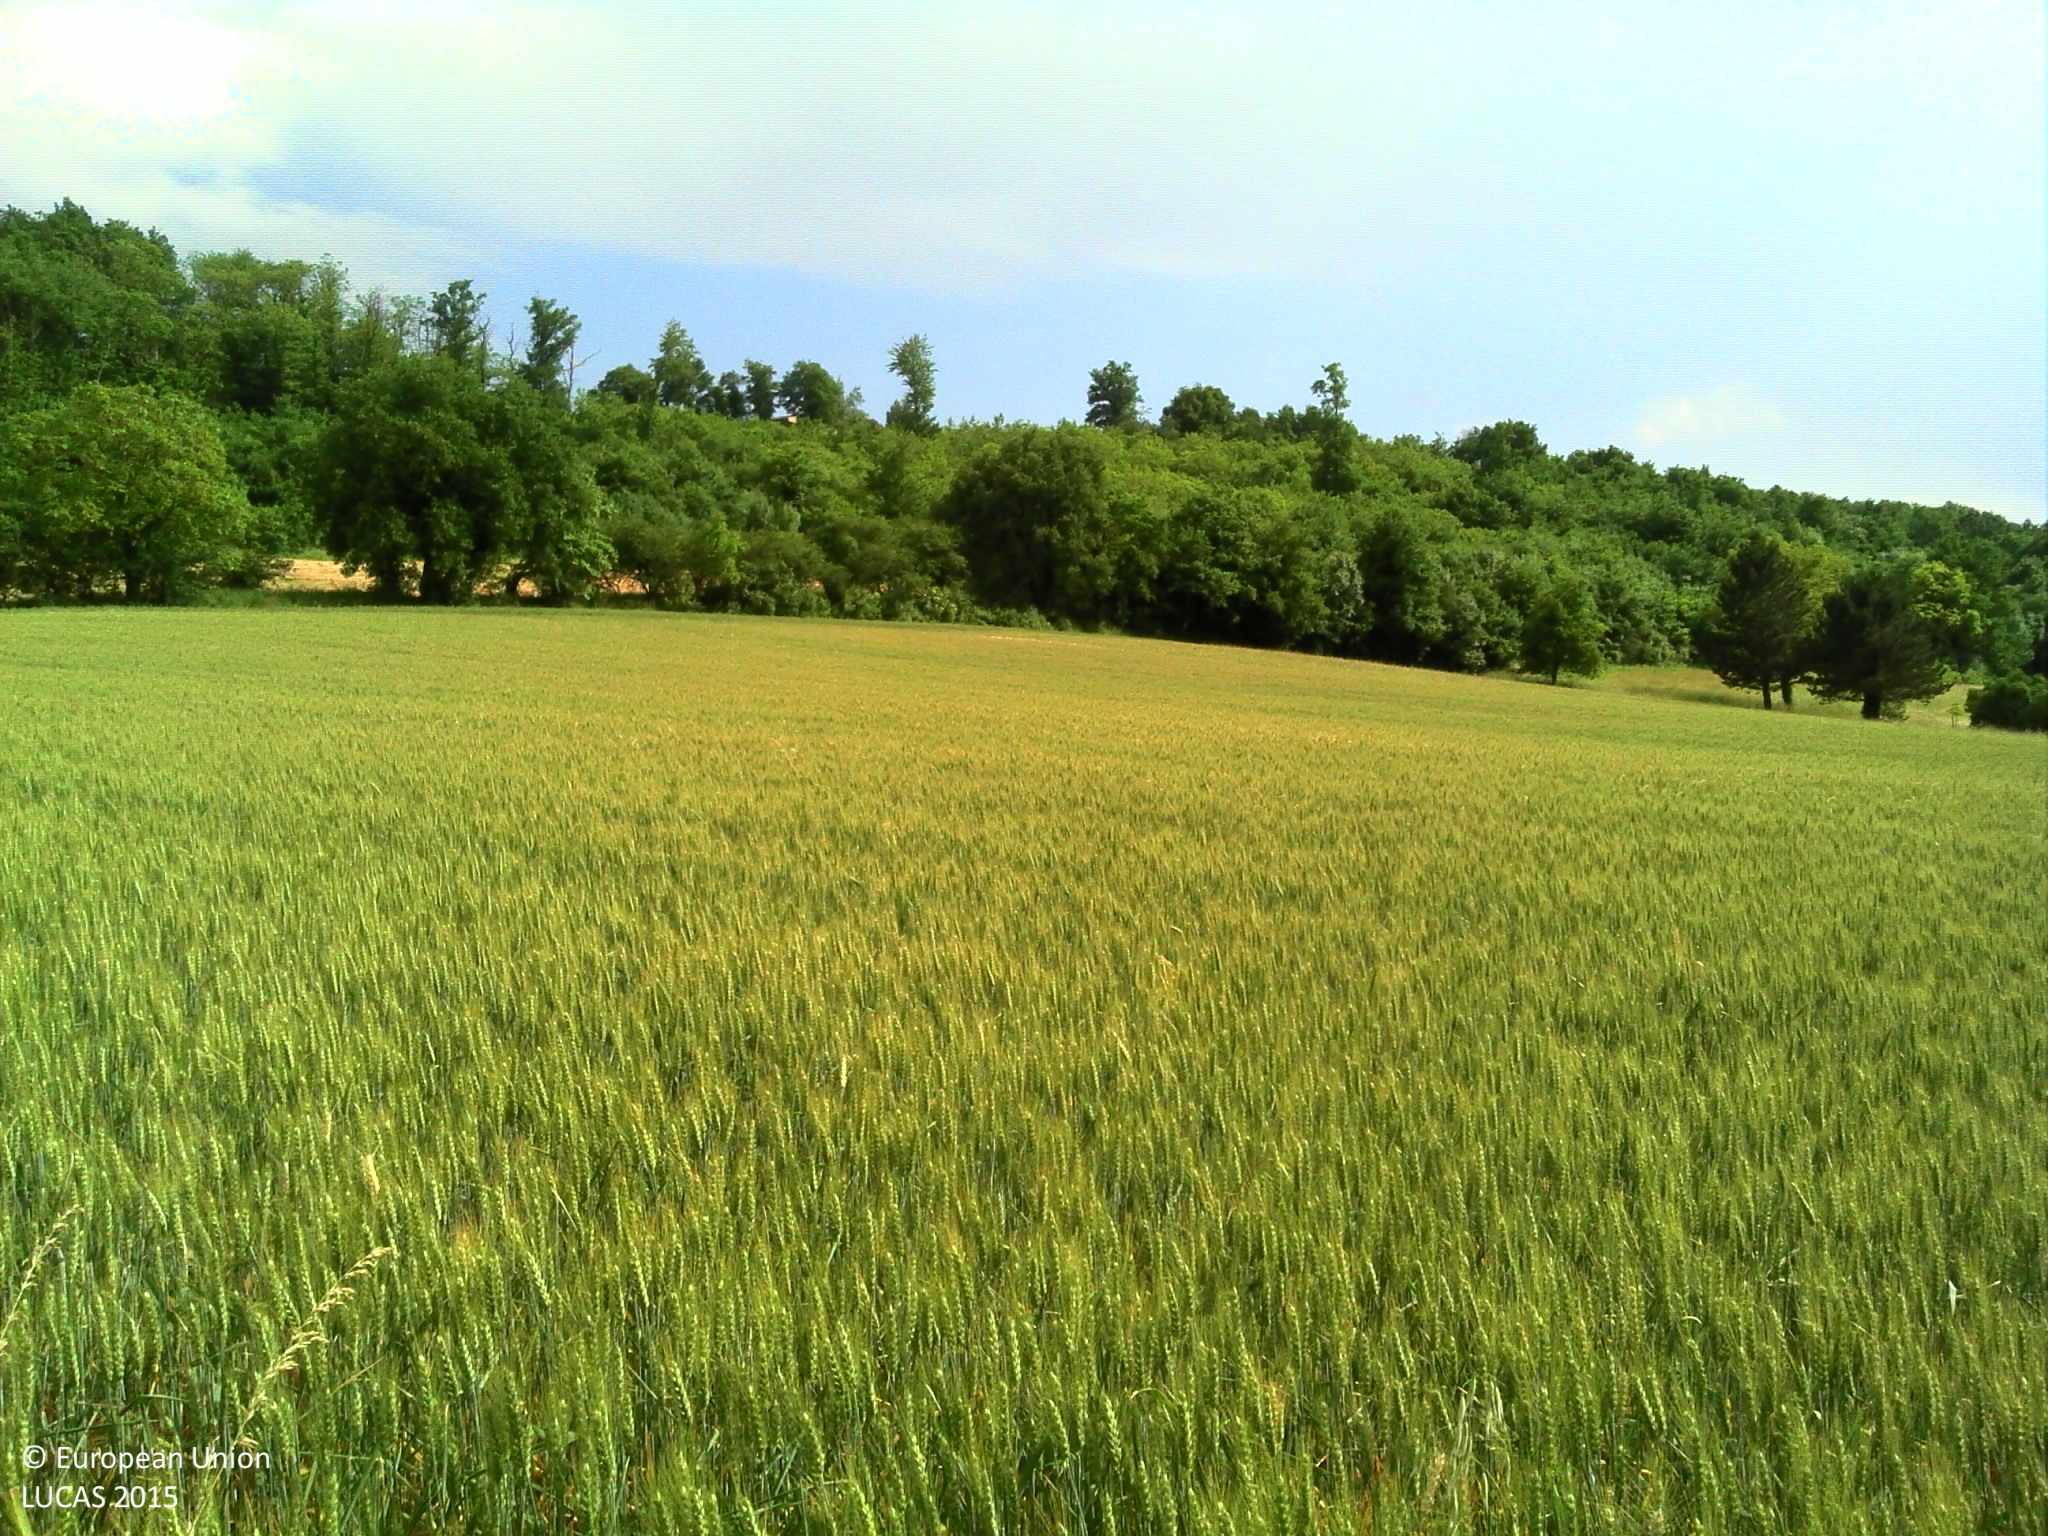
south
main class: Cropland
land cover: Durum wheat
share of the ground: > 75 %
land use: Agriculture (excluding fallow land and kitchen gardens)
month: May
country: FR
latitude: 45.1156
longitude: 5.0097
